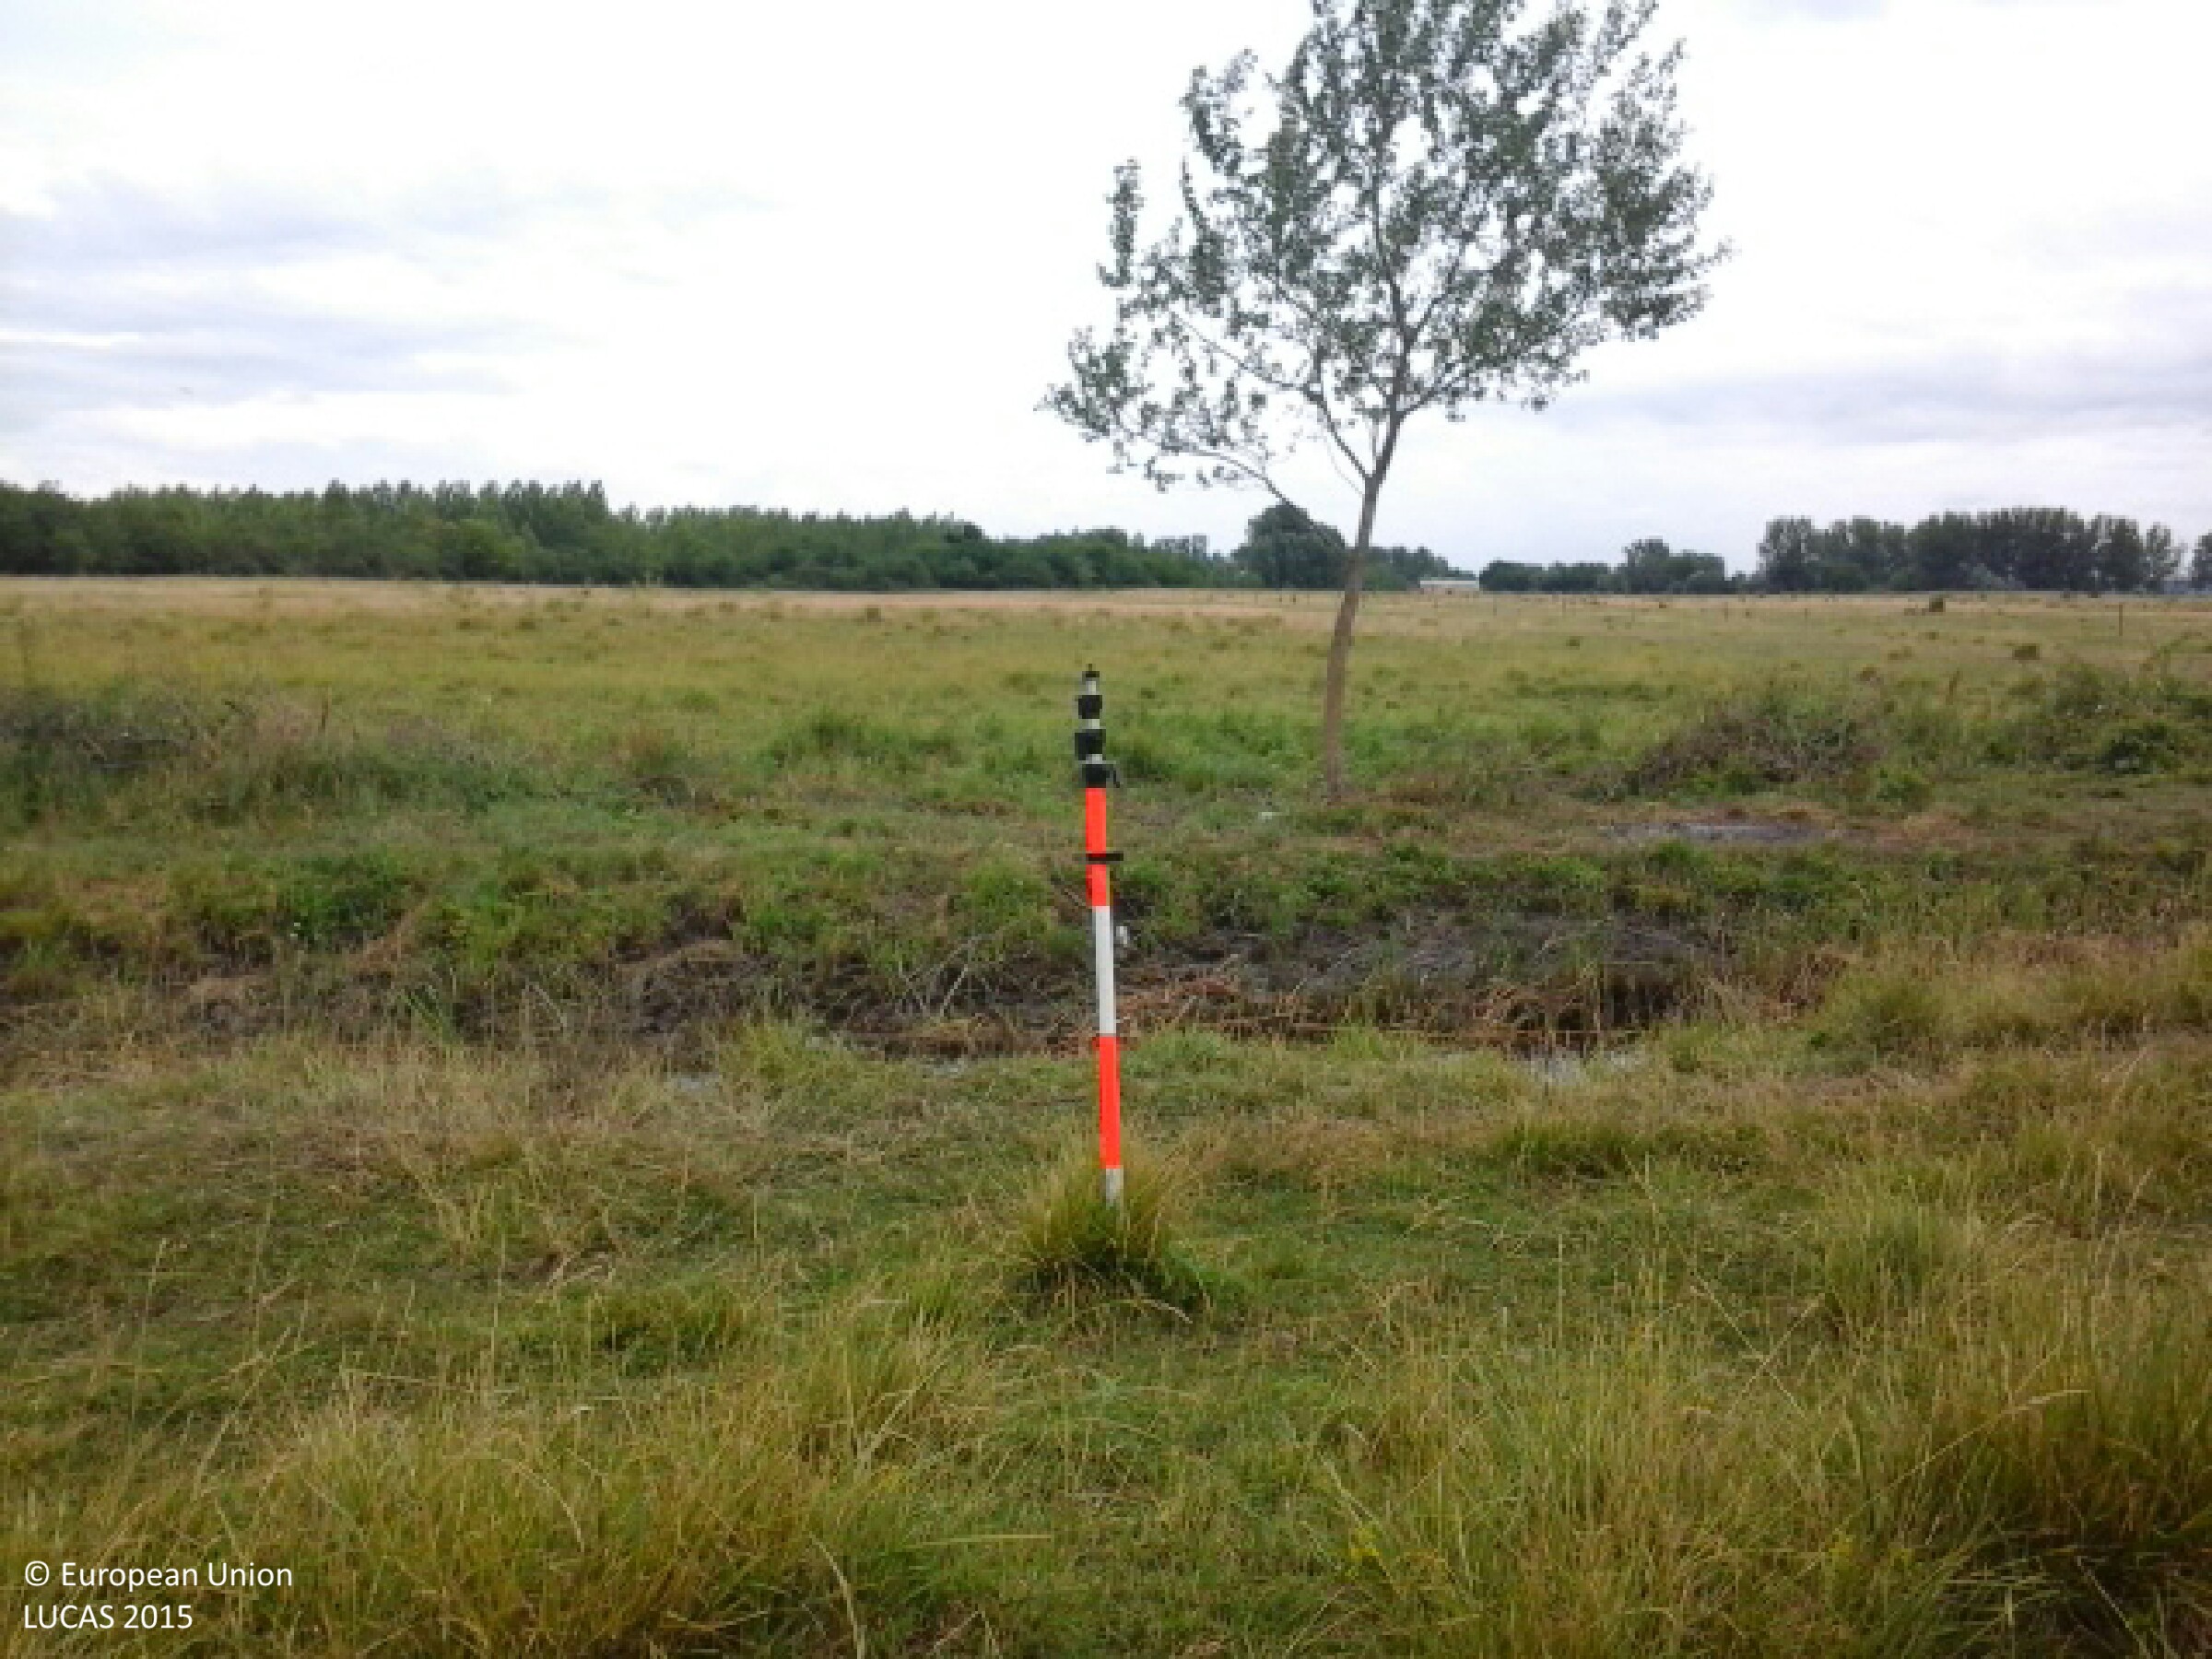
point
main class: Grassland
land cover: Grassland without tree/shrub cover
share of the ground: > 75 %
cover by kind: herbaceous plants 100 %
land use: Agriculture (excluding fallow land and kitchen gardens)
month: June
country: HU
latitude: 48.0595
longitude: 21.4636
